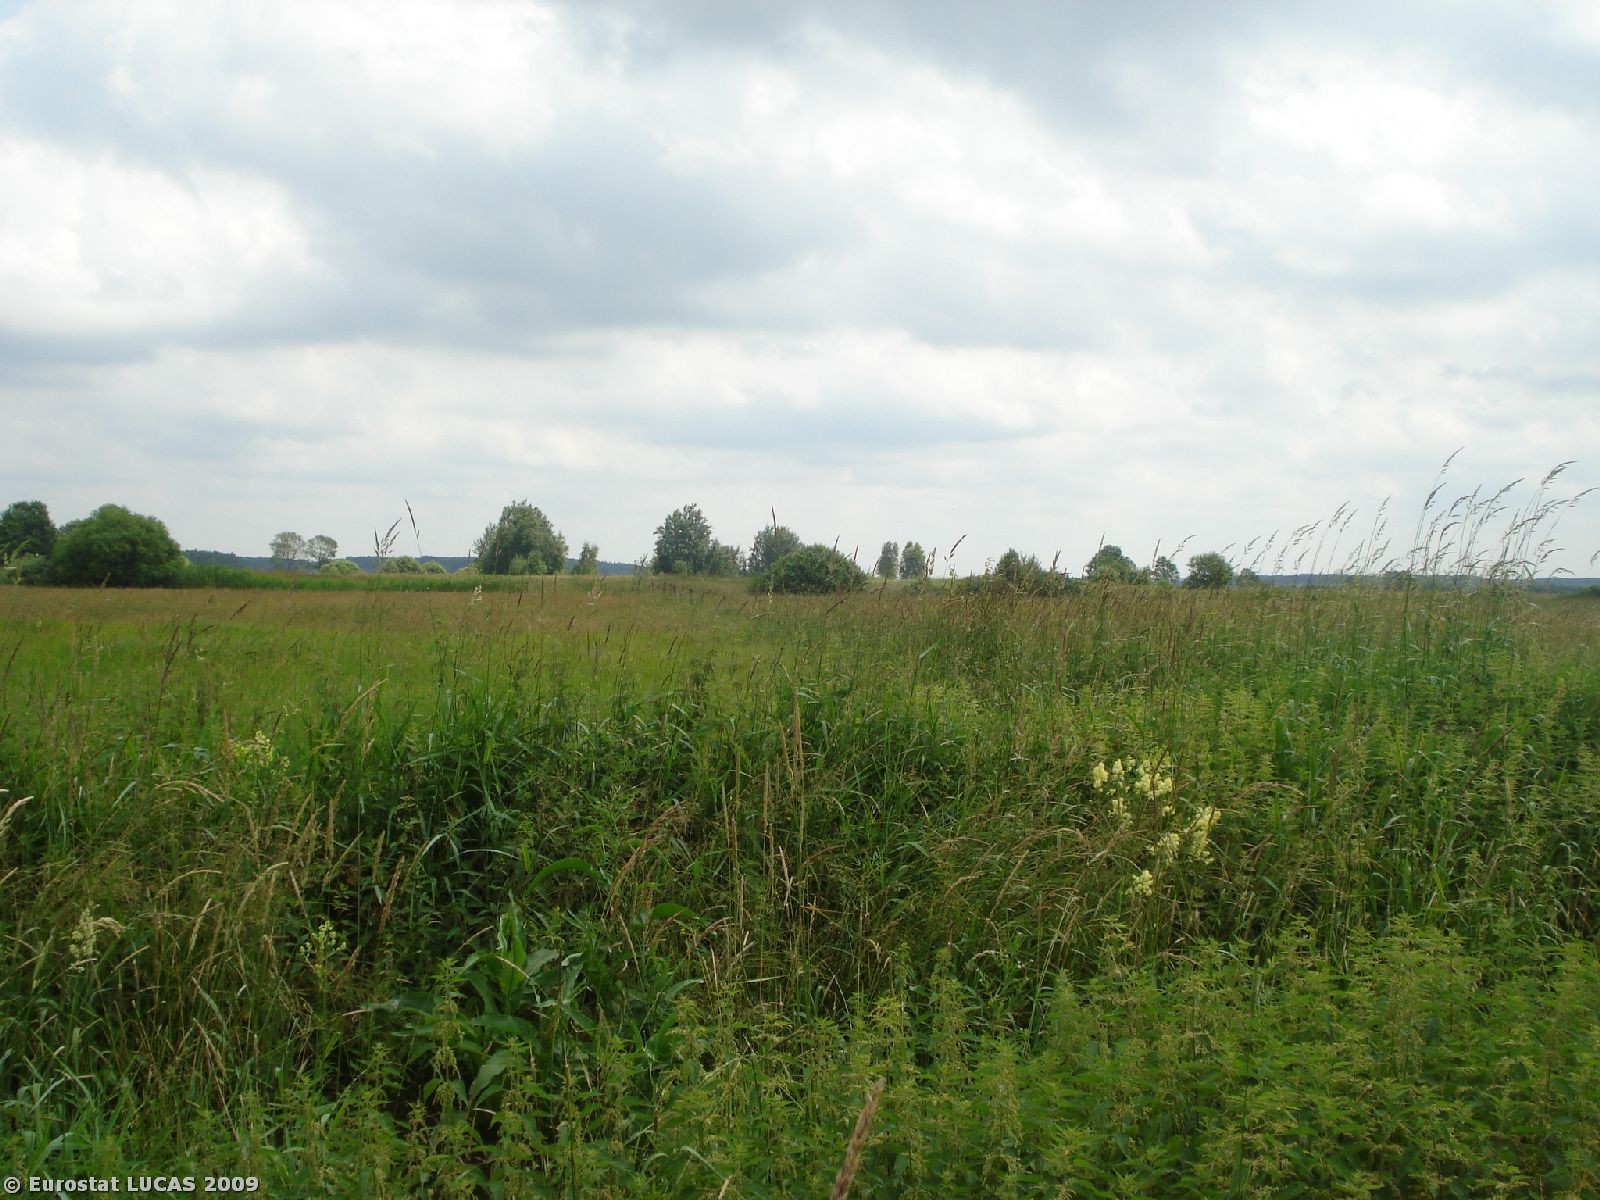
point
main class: Grassland
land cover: Grassland with sparse tree/shrub cover
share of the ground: > 75 %
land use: Agriculture (excluding fallow land and kitchen gardens)
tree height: > 5 m
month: July
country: PL
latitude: 52.6226
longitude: 23.1810
